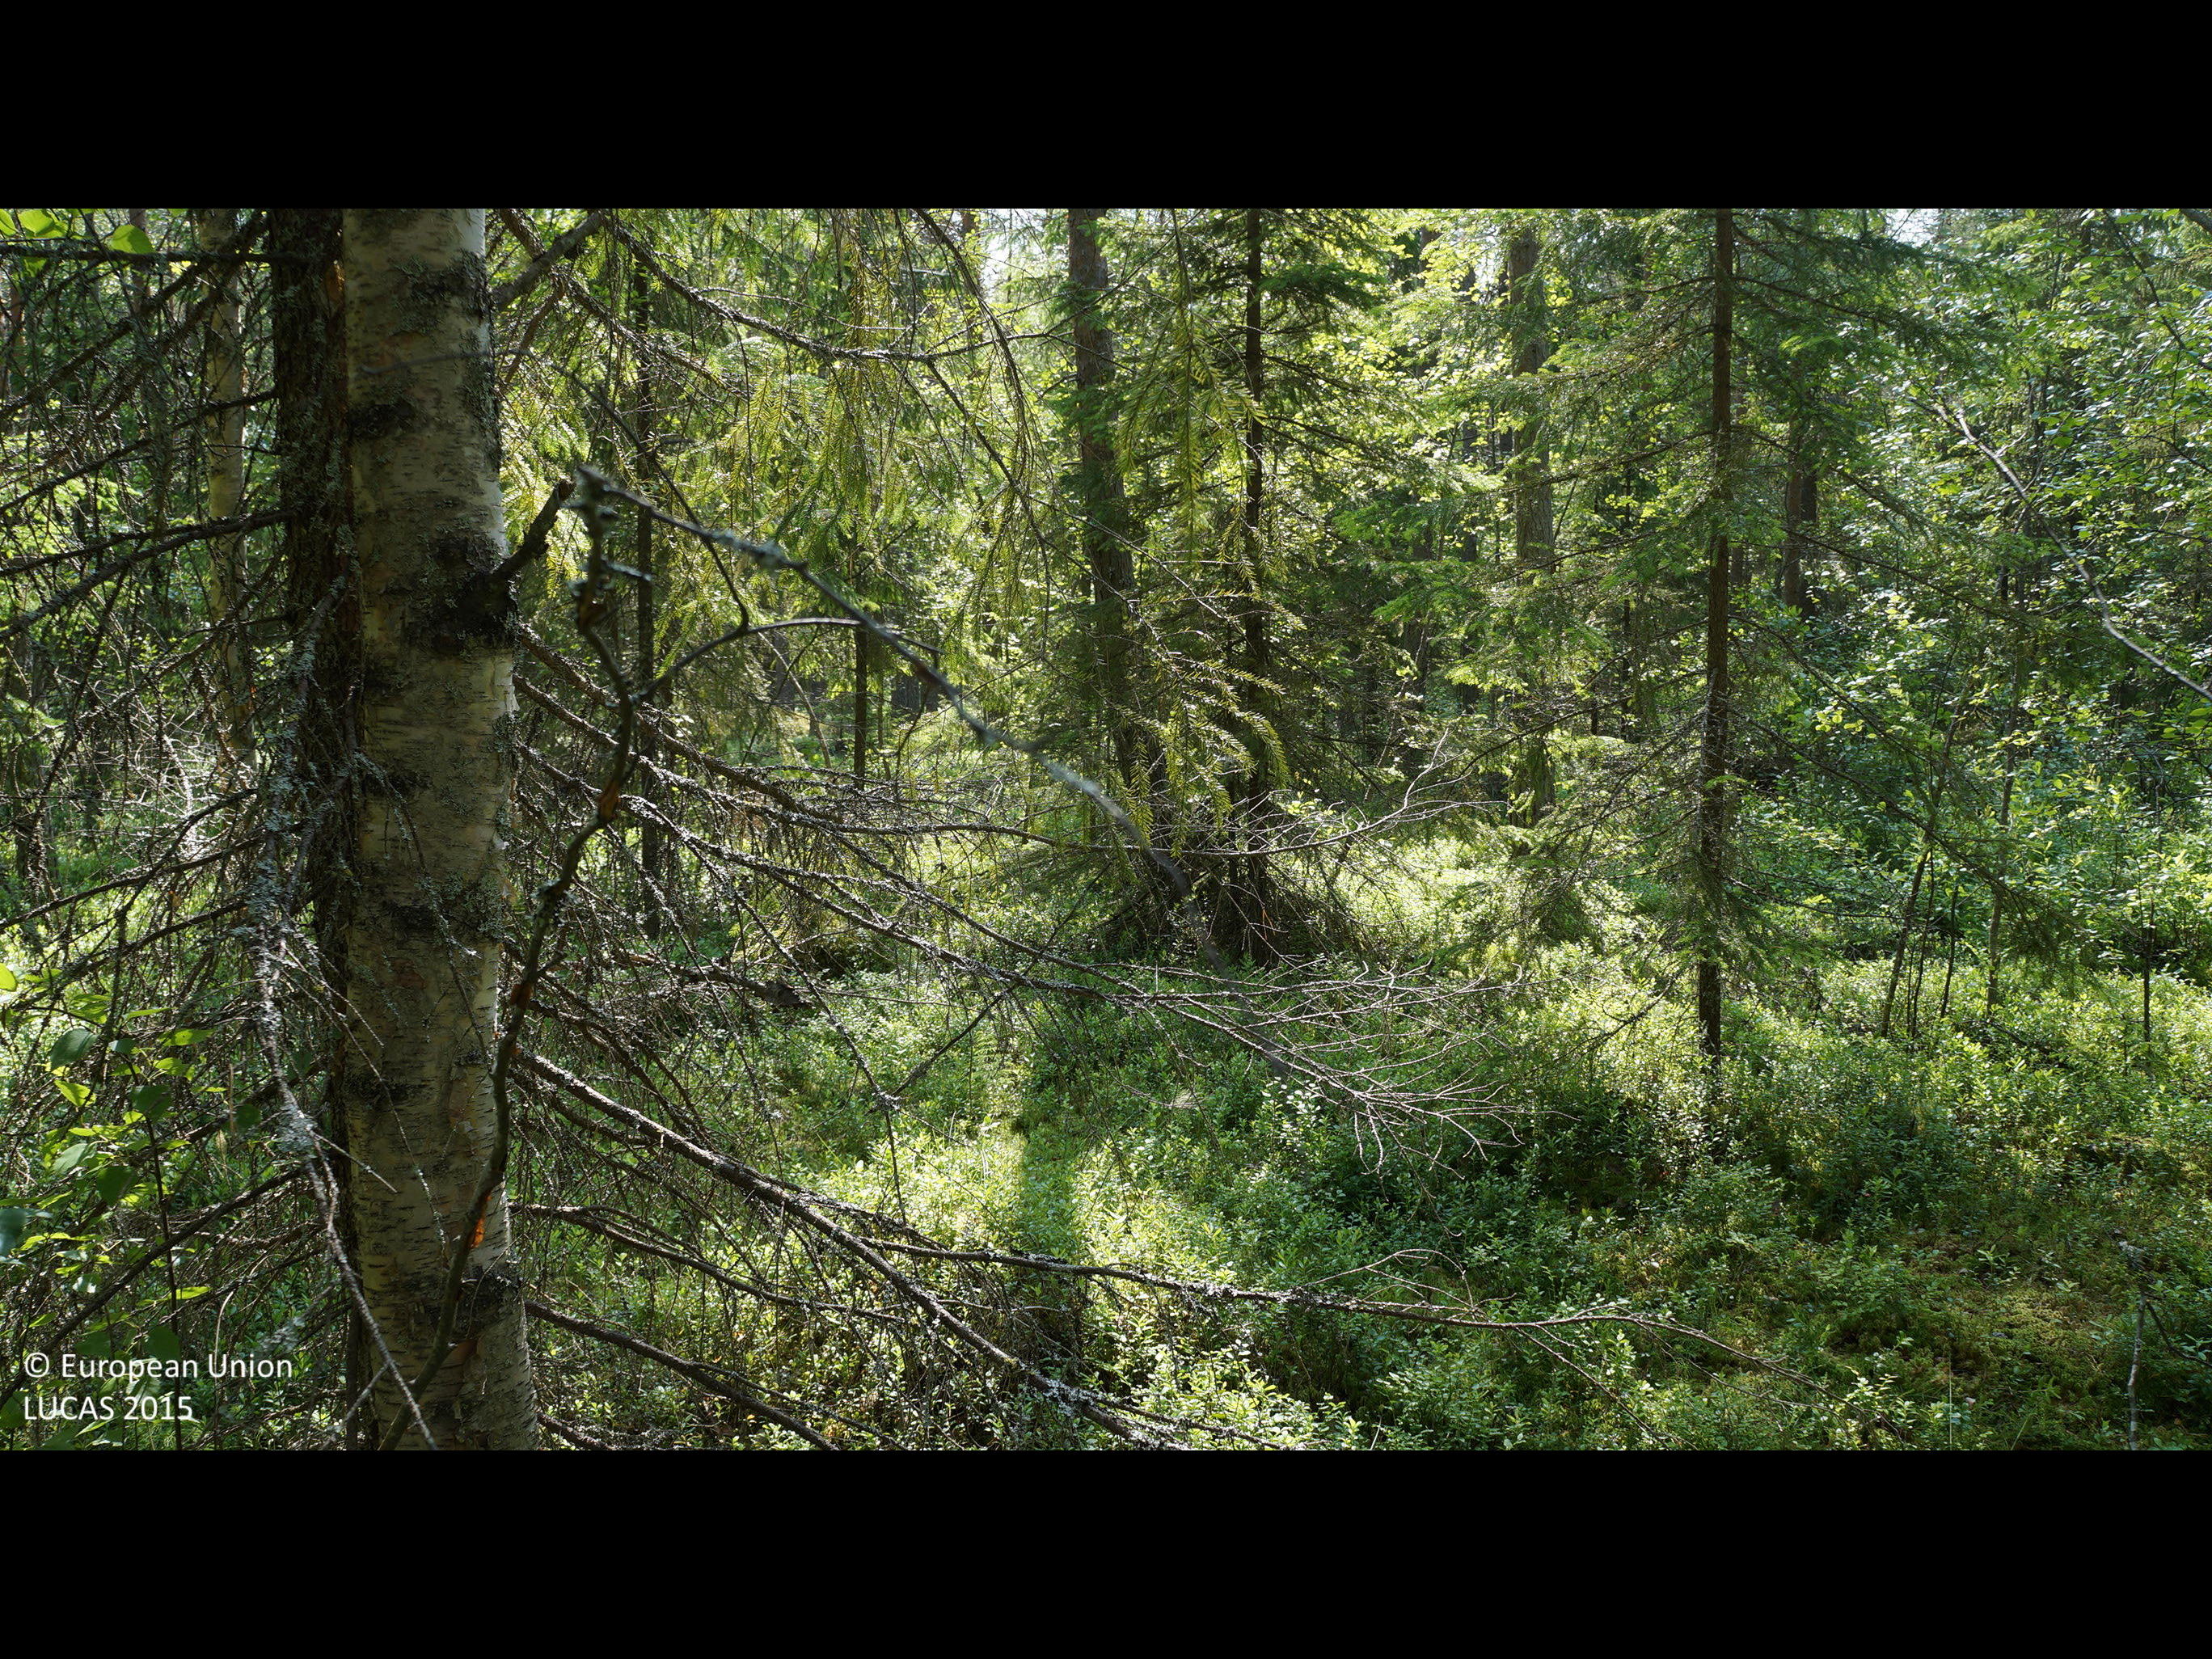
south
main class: Woodland
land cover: Pine dominated coniferous woodland
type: boreal forest
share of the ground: 50 - 75 %
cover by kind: coniferous forest trees 65 %, shrubs 20 %, broadleaved forest trees 5 %, herbaceous plants 5 %, lichens and mosses 5 %
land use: Forestry
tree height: > 5 m
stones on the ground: < 10 %
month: July
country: FI
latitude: 64.4953
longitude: 24.3665
